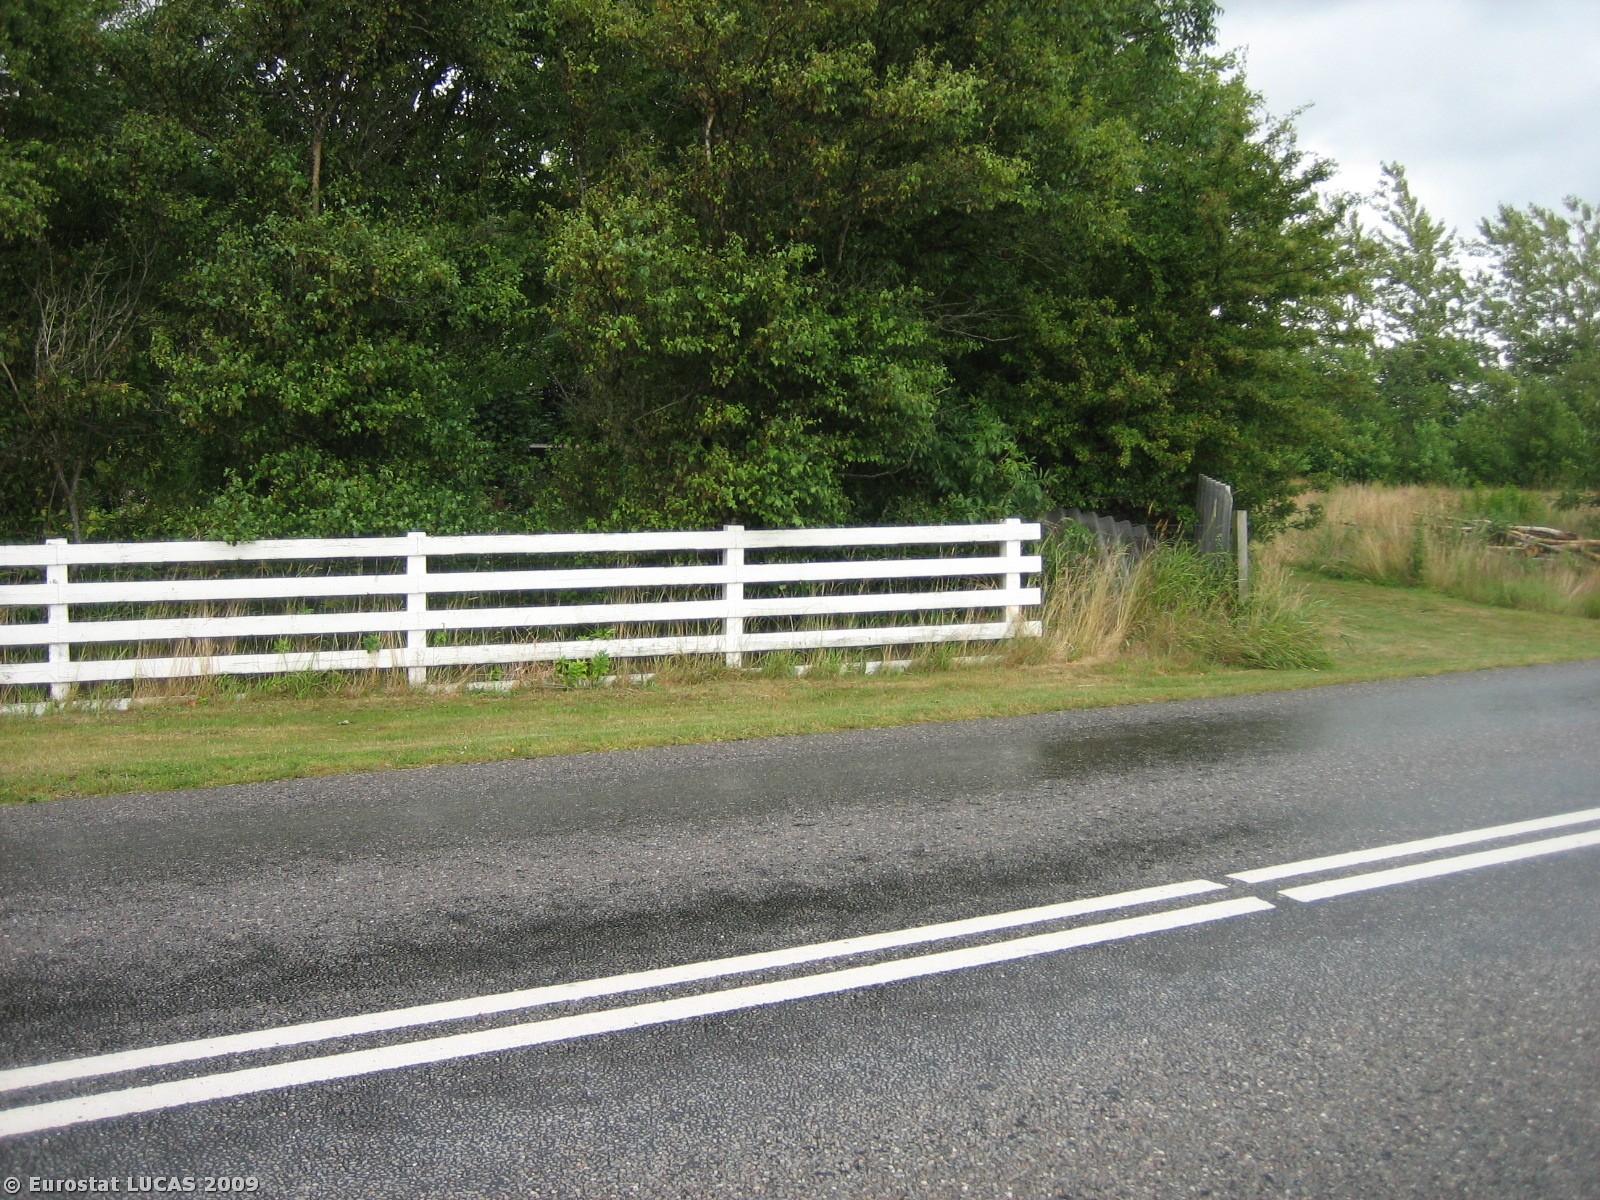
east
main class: Cropland
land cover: Common wheat
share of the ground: > 75 %
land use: Agriculture (excluding fallow land and kitchen gardens)
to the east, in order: Common wheat; Grass margins; Paved roads, cycling and walking lanes; Shrubland with sparse tree cover; Grassland without tree/shrub cover; Broadleaved woodland; Grass margins; Tracks; Grass margins; Broadleaved woodland; Barley
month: July
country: DK
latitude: 55.6380
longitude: 8.3652
